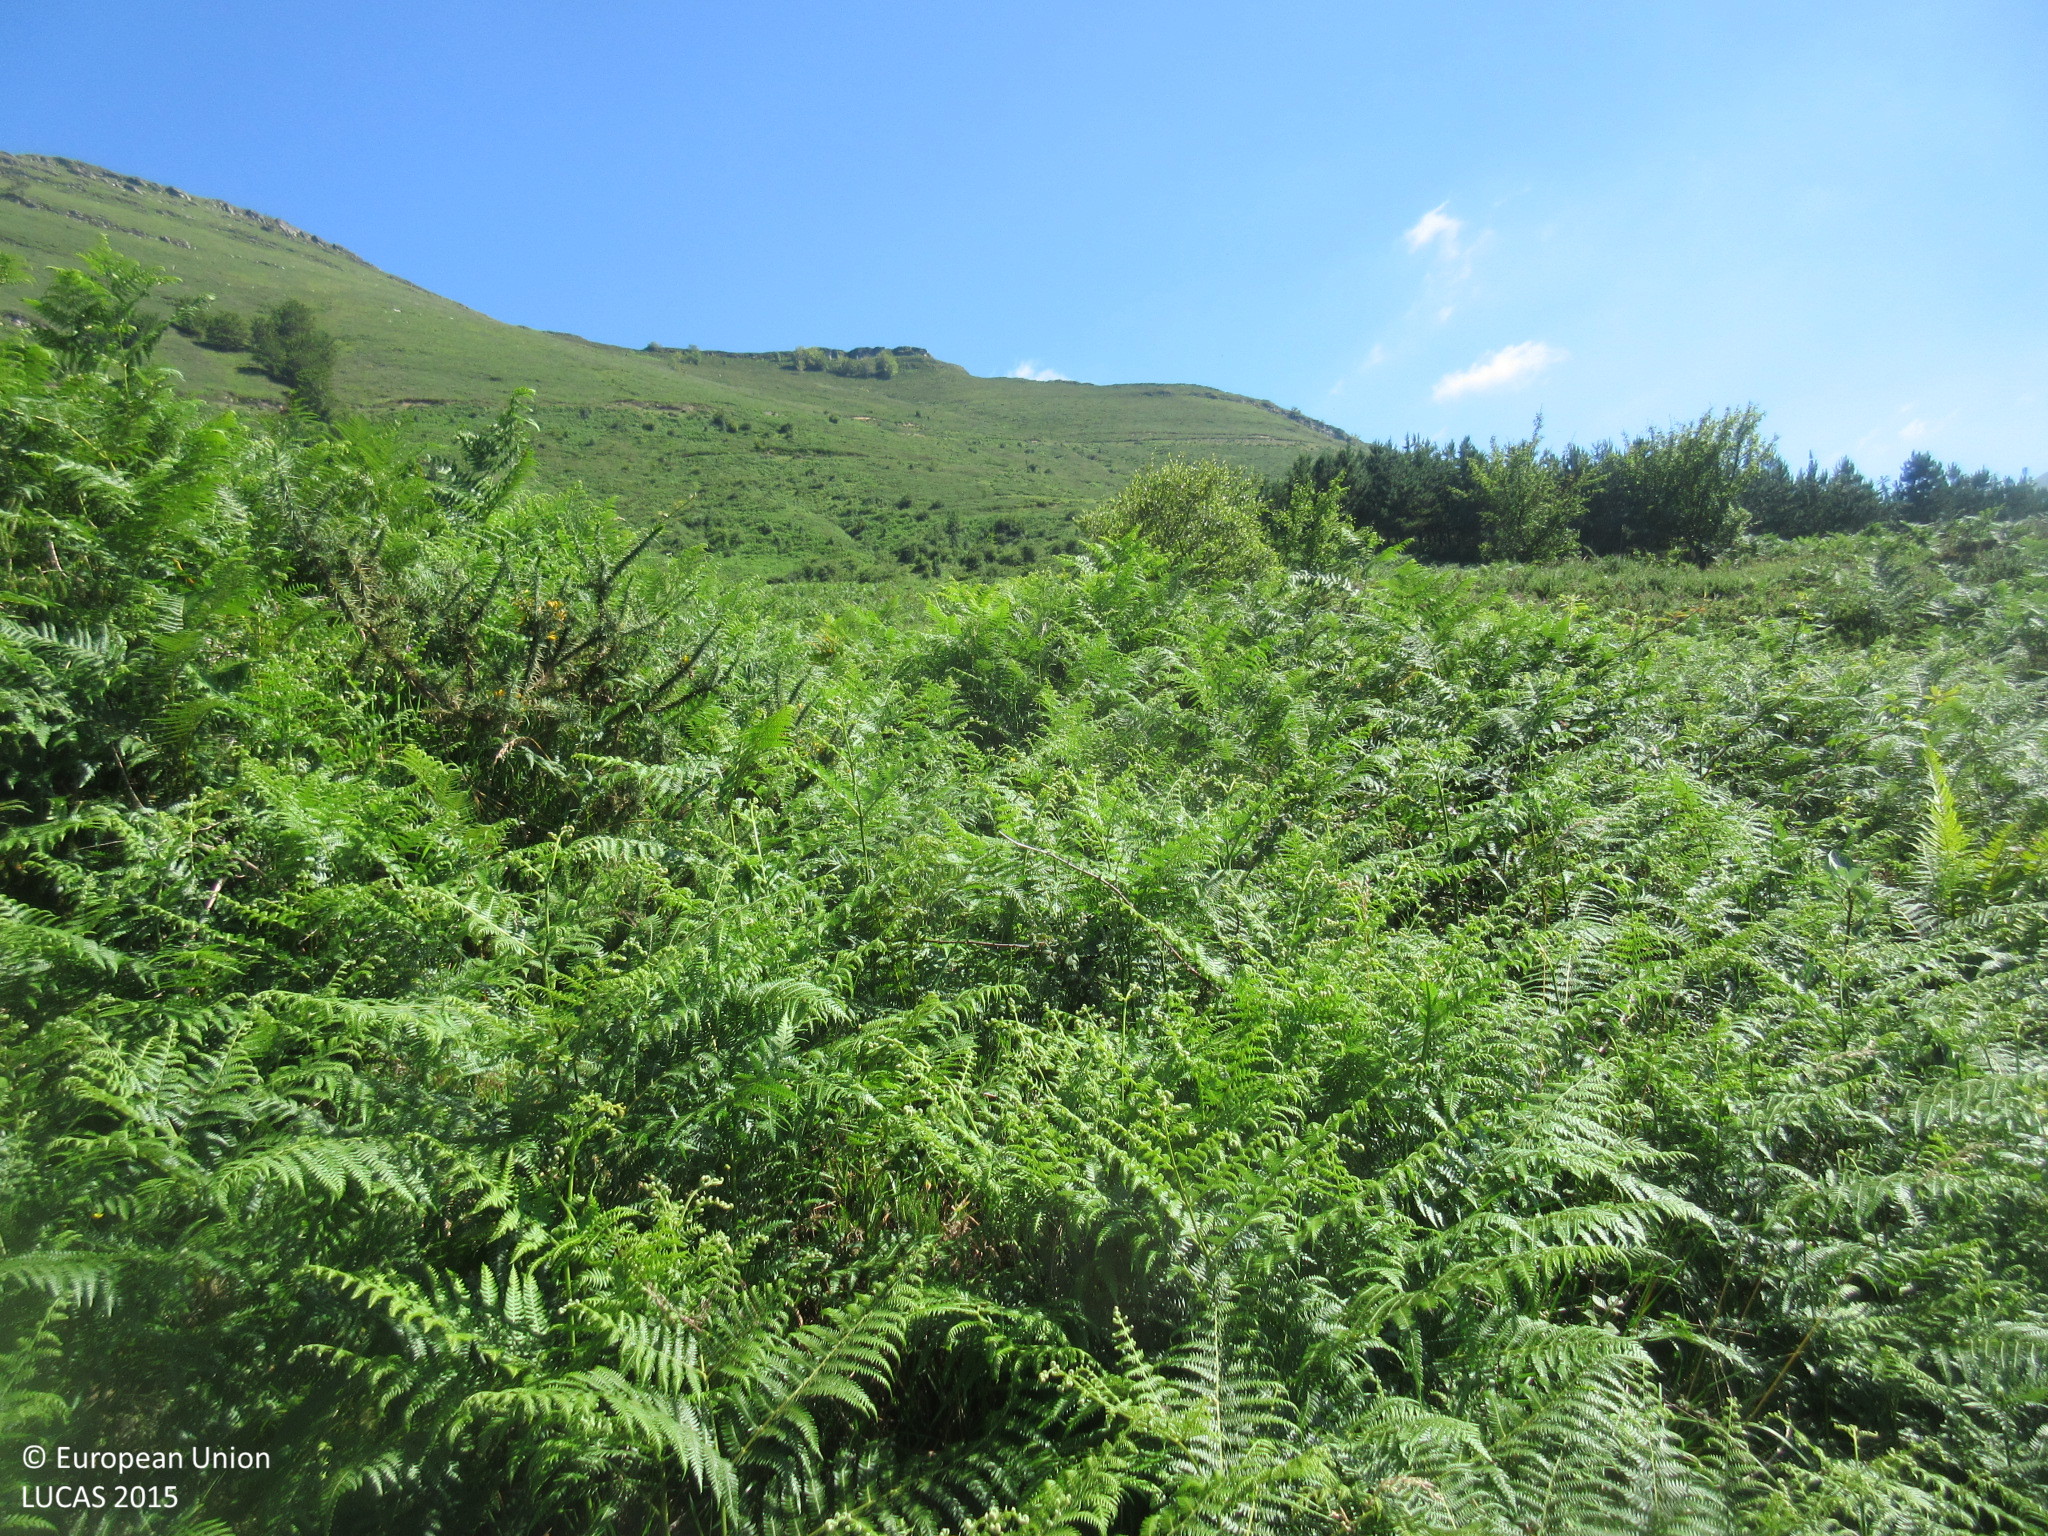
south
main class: Shrubland
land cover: Shrubland with sparse tree cover
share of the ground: > 75 %
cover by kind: shrubs 95 %, broadleaved forest trees 5 %
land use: Forestry
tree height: > 5 m
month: July
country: ES
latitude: 43.1651
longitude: -3.4099
